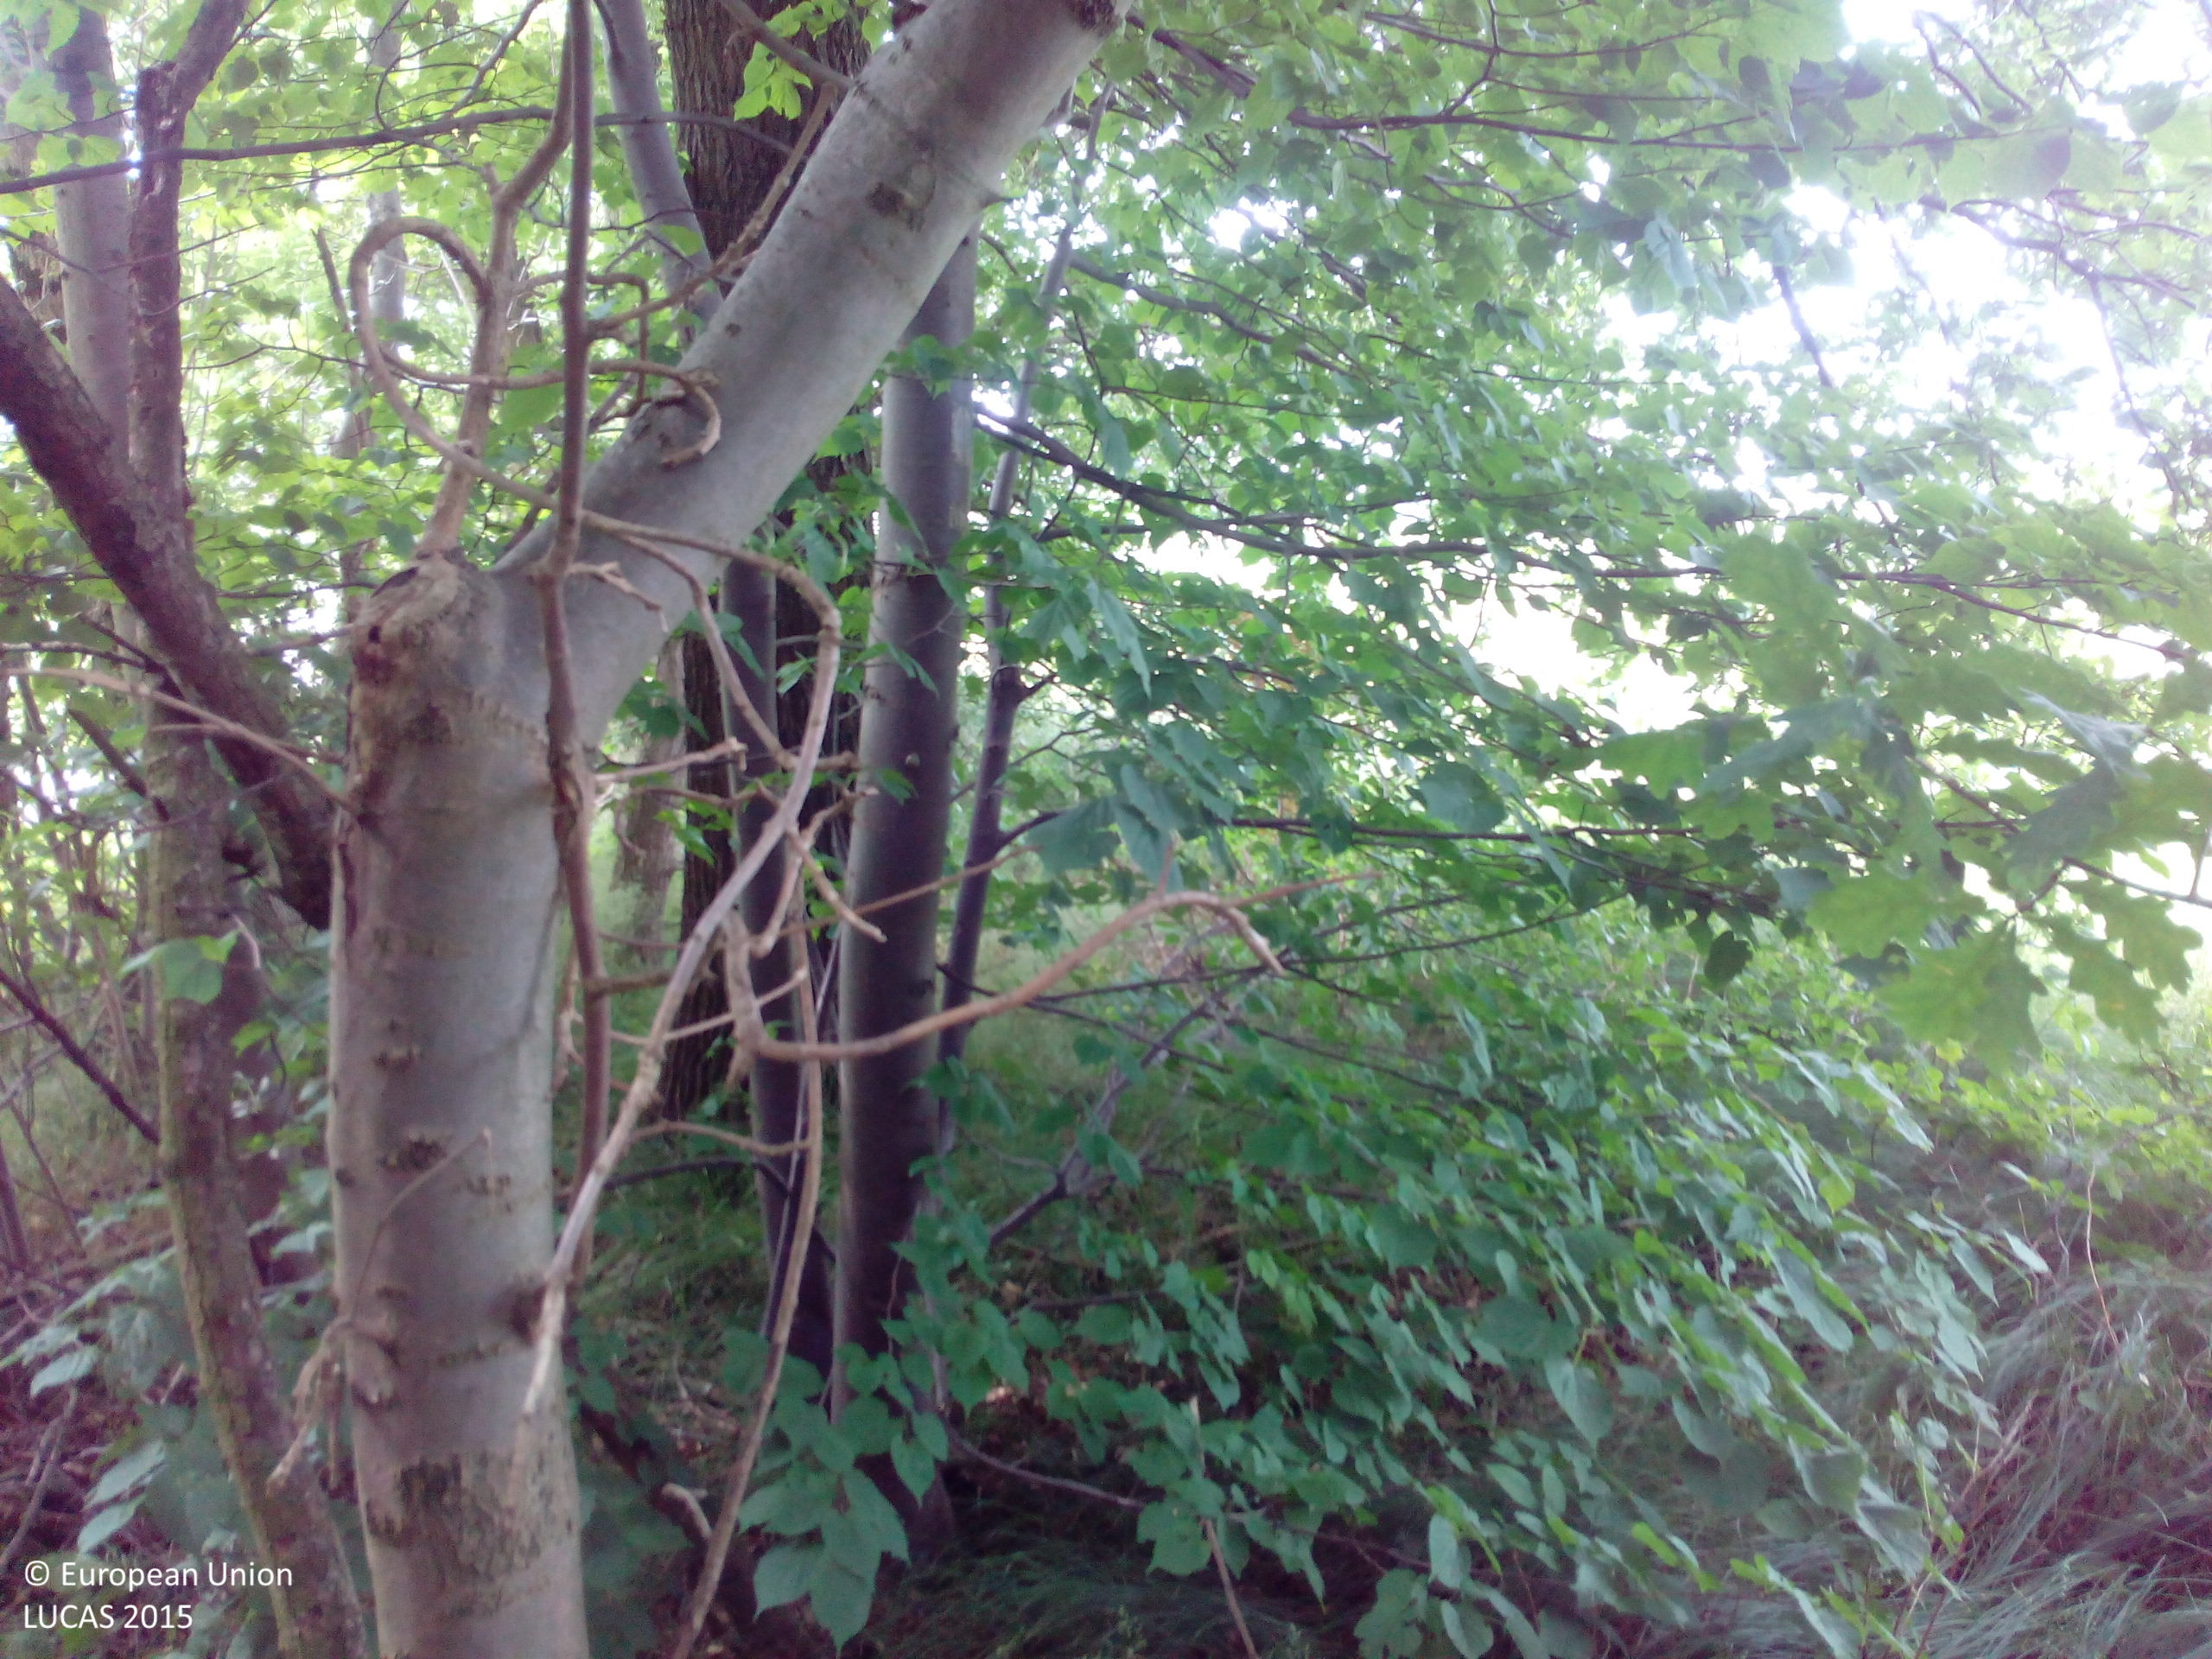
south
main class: Woodland
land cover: Broadleaved woodland
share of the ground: > 75 %
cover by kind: broadleaved forest trees 90 %, shrubs 5 %, unconsolidated bare surface 5 %
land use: Semi-natural and natural areas not in use
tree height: > 5 m
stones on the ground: 10 - 25 %
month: June
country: DE
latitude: 51.2483
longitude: 13.9981
